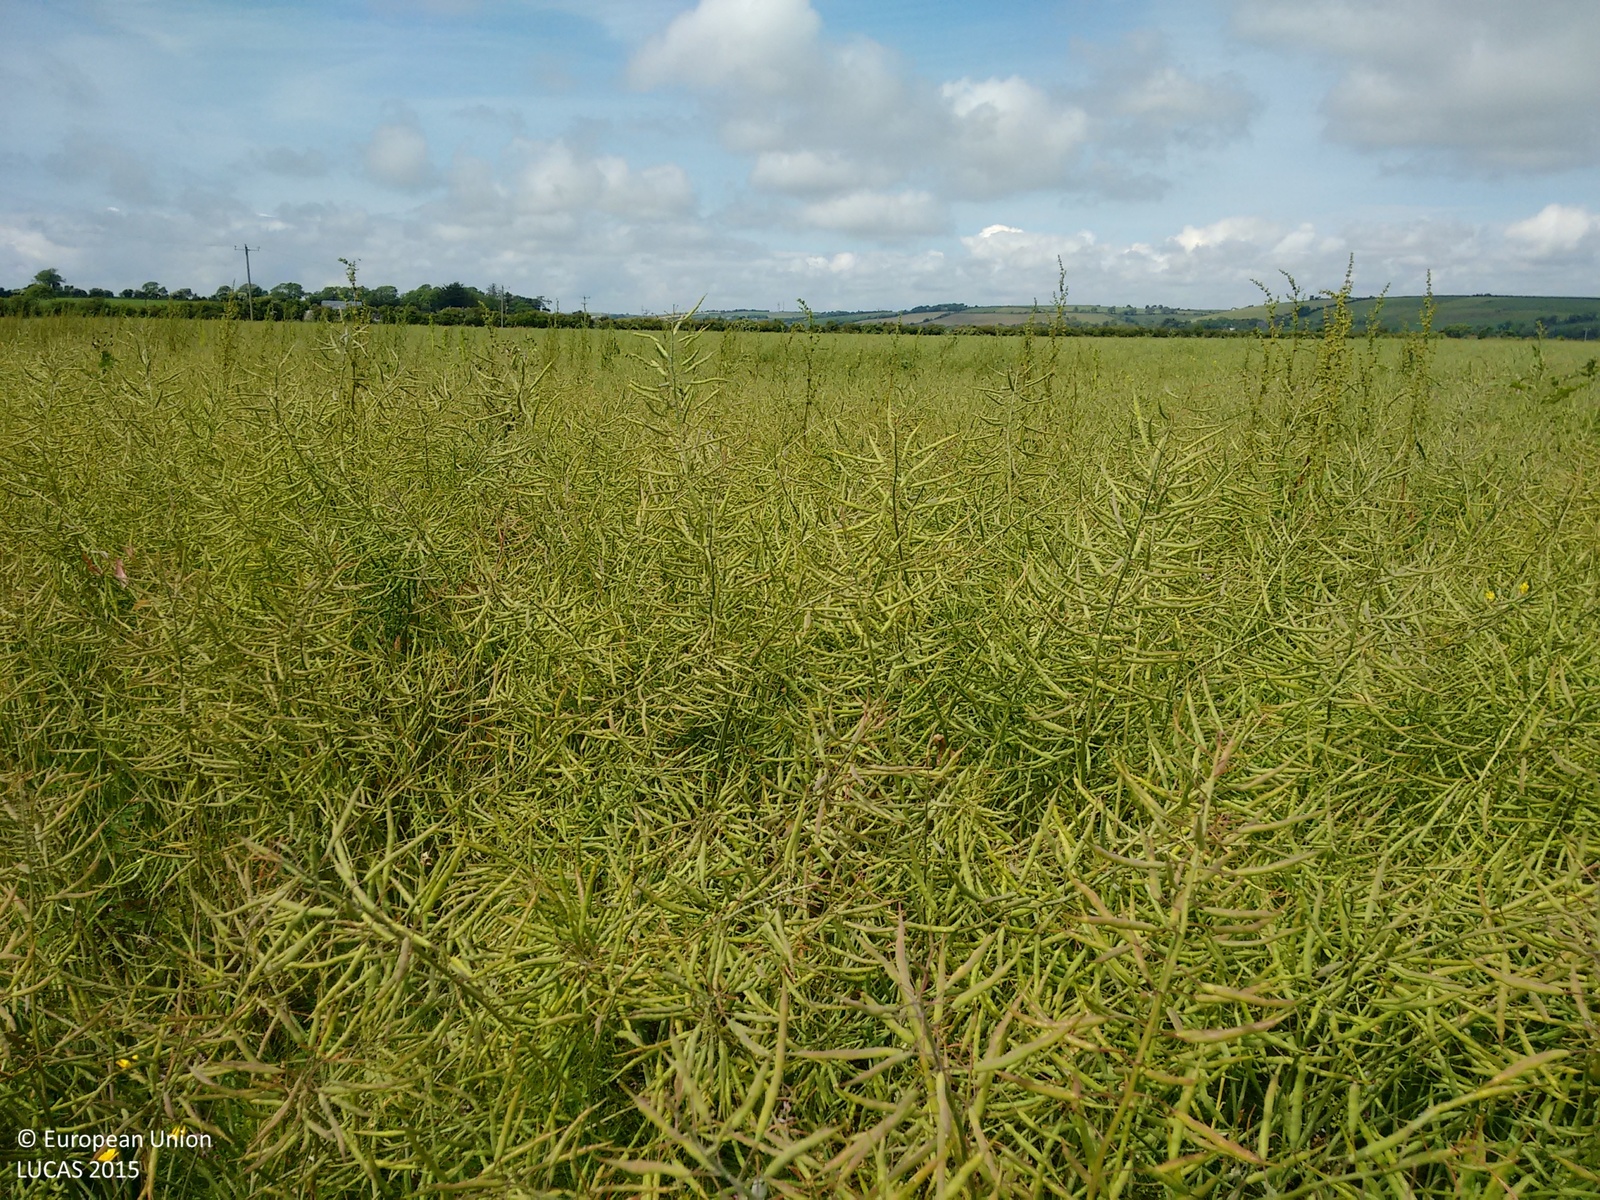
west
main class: Cropland
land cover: Rape and turnip rape
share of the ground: > 75 %
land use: Agriculture (excluding fallow land and kitchen gardens)
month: June
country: IE
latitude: 51.8573
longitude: -8.0816
